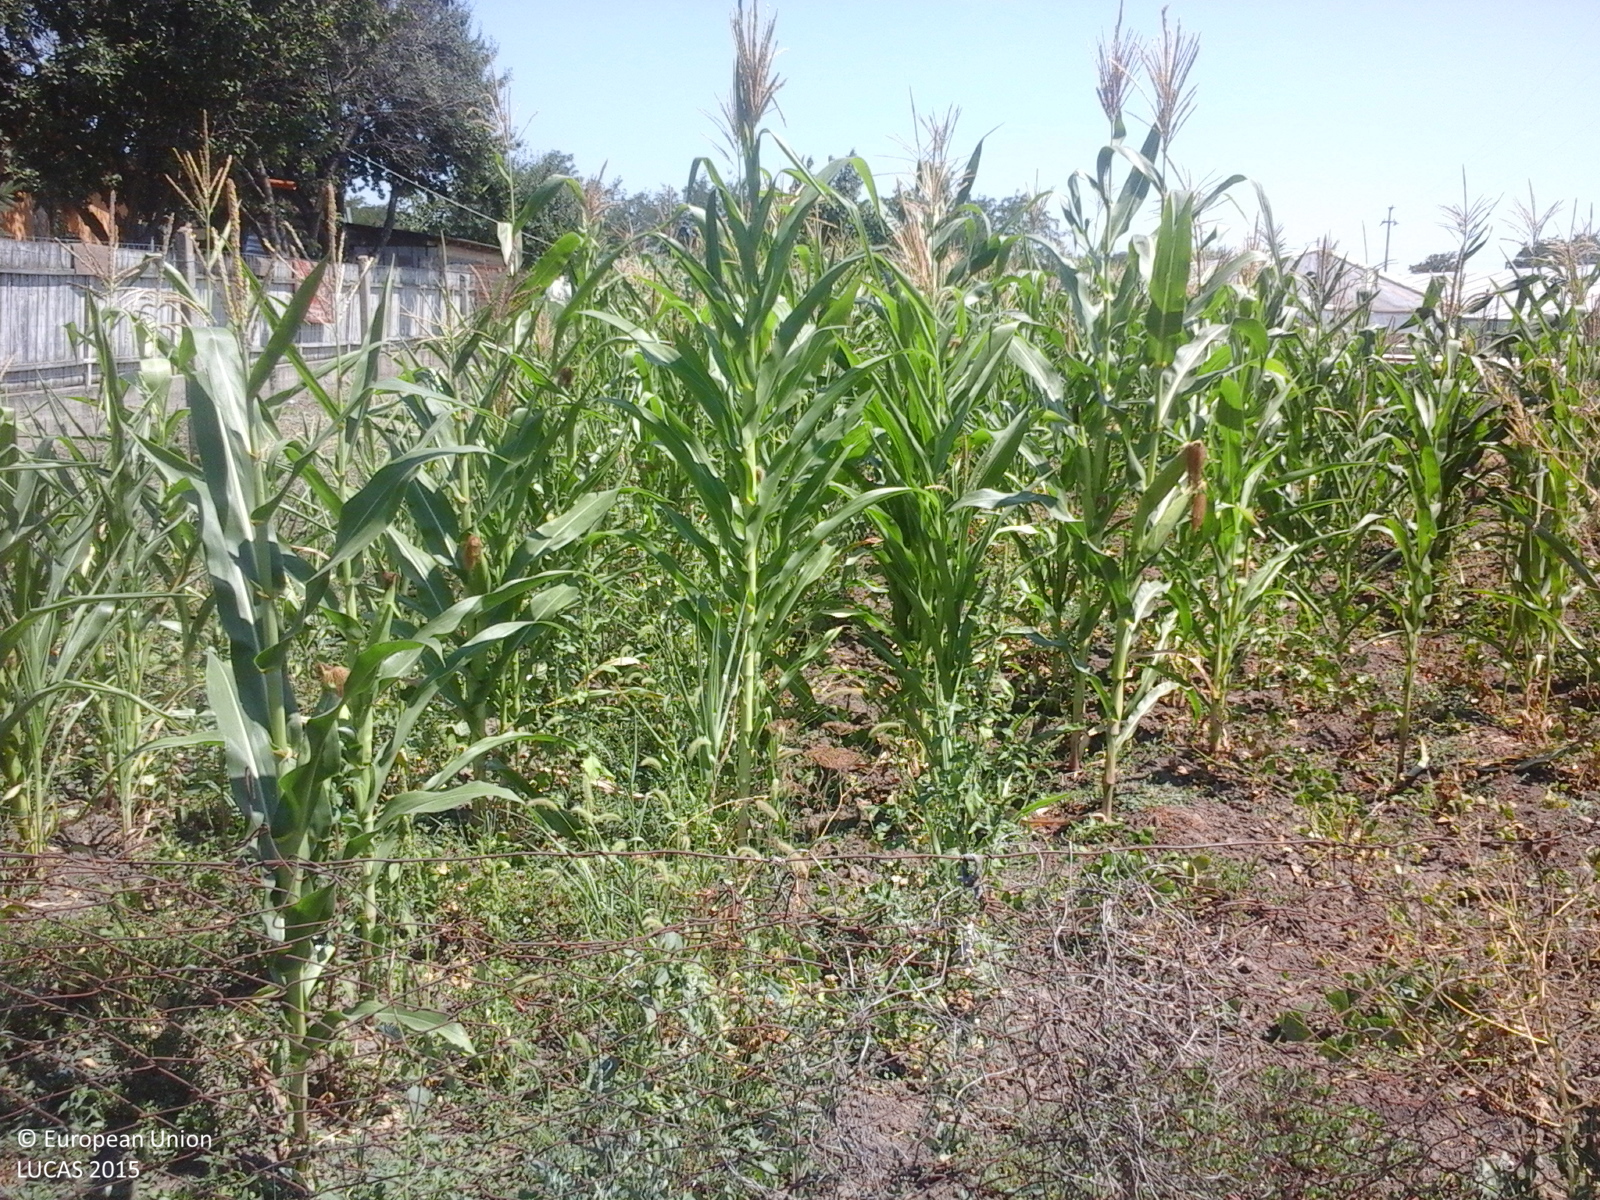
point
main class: Cropland
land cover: Maize
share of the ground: > 75 %
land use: Agriculture (excluding fallow land and kitchen gardens)
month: August
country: RO
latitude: 45.7636
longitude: 27.4748
